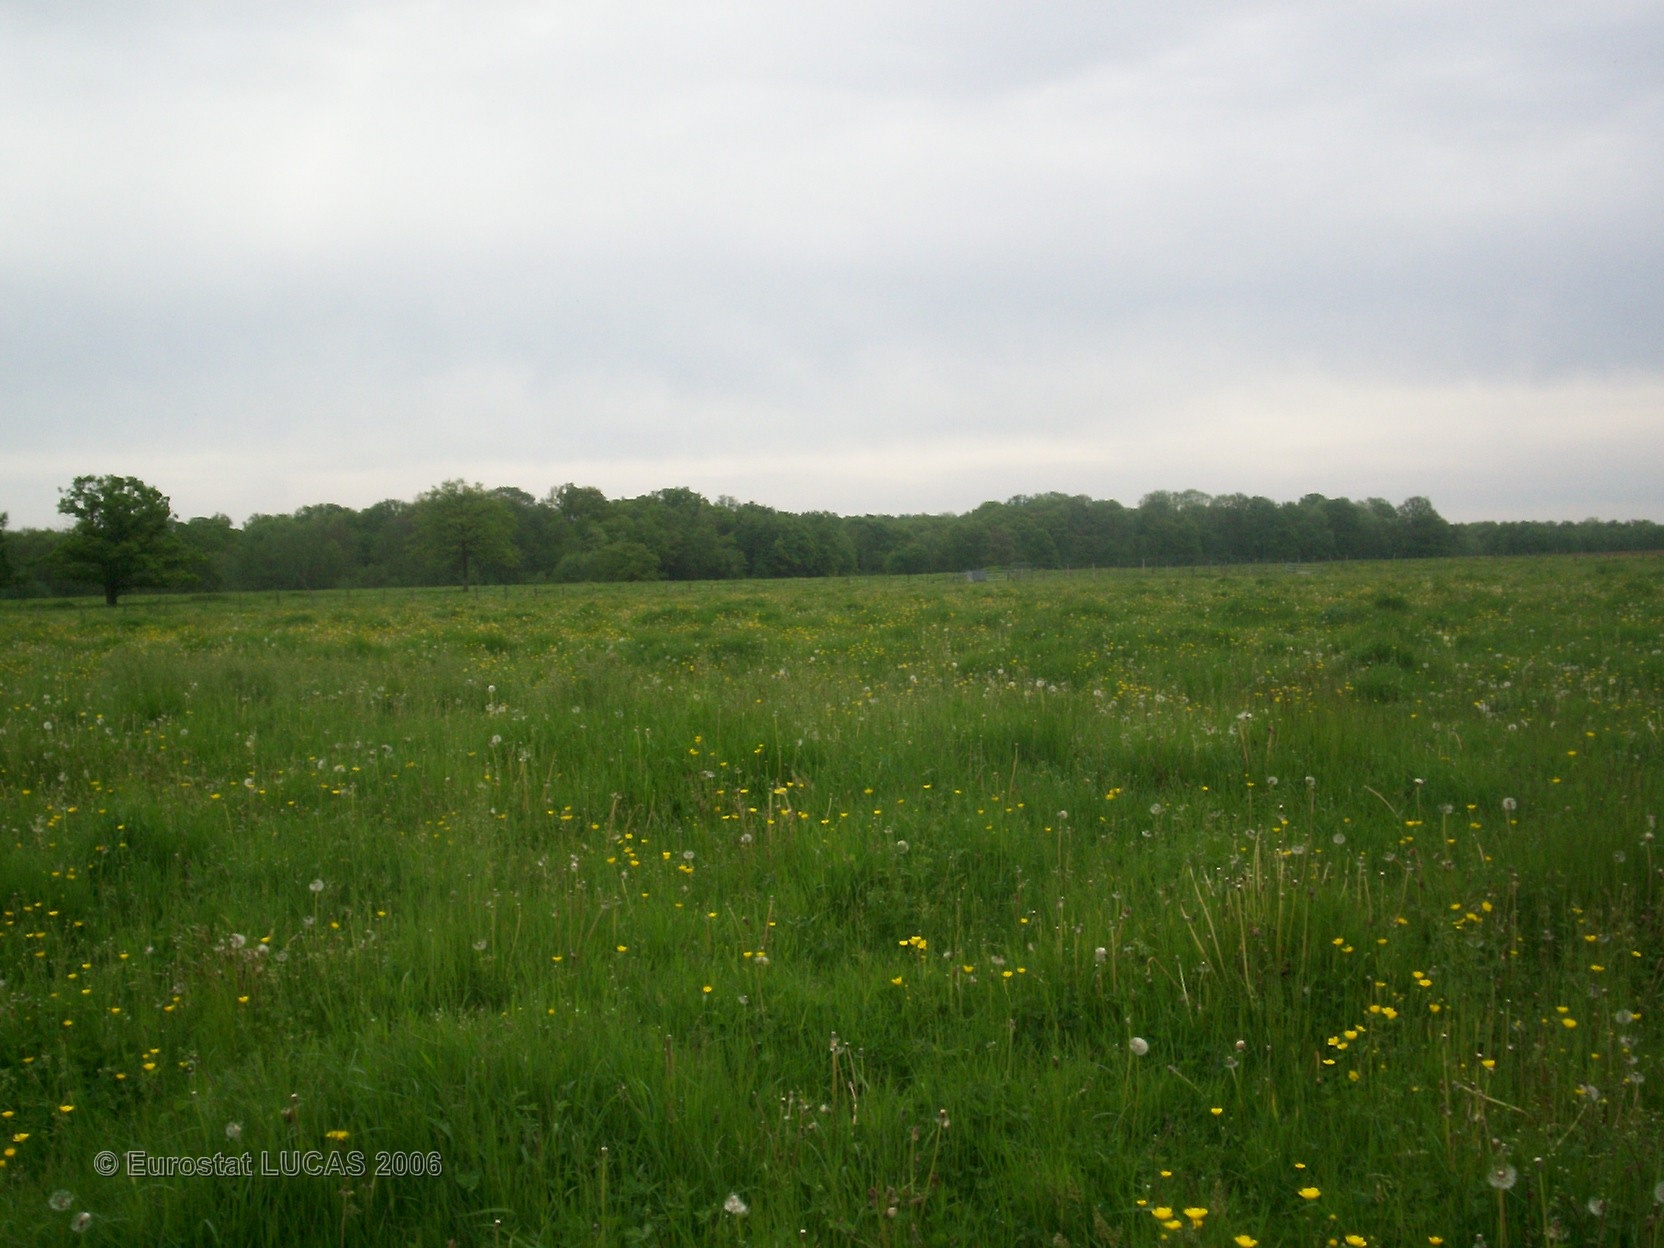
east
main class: Grassland
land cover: Grassland without tree/shrub cover
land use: Agriculture (excluding fallow land and kitchen gardens)
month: May
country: FR
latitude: 48.4995
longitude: 4.8418
